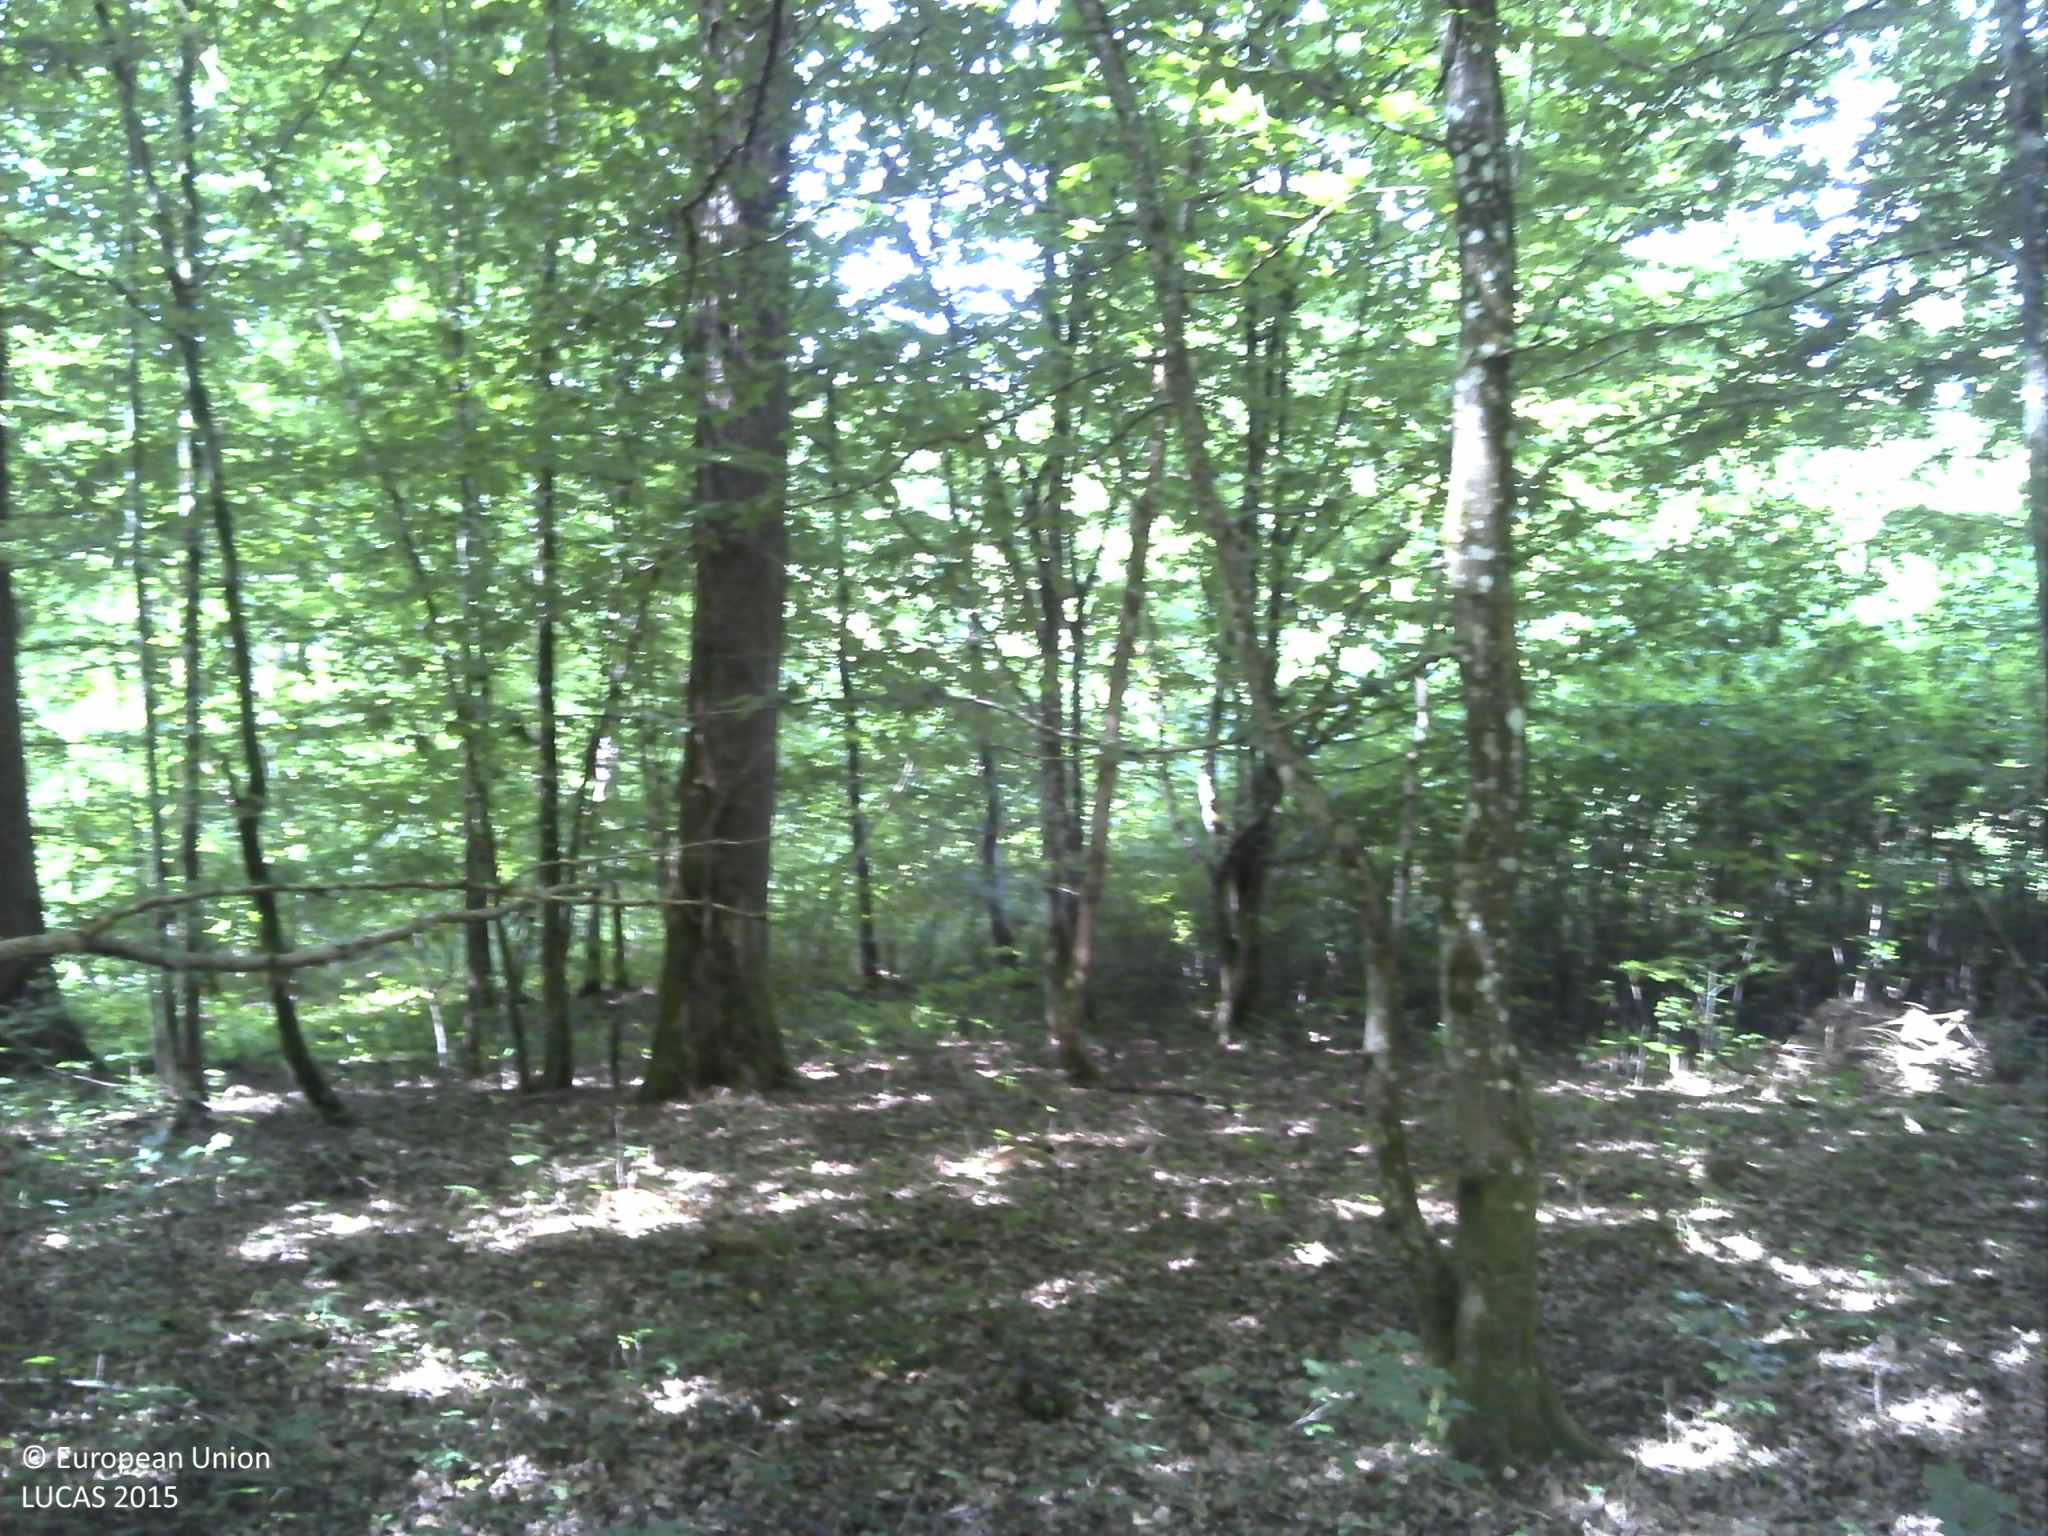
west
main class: Woodland
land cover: Broadleaved woodland
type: beech forest
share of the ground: 50 - 75 %
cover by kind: broadleaved forest trees 75 %, herbaceous plants 15 %, consolidated bare surface 10 %
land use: Forestry
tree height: > 5 m
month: June
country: FR
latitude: 49.7321
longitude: 4.2377
